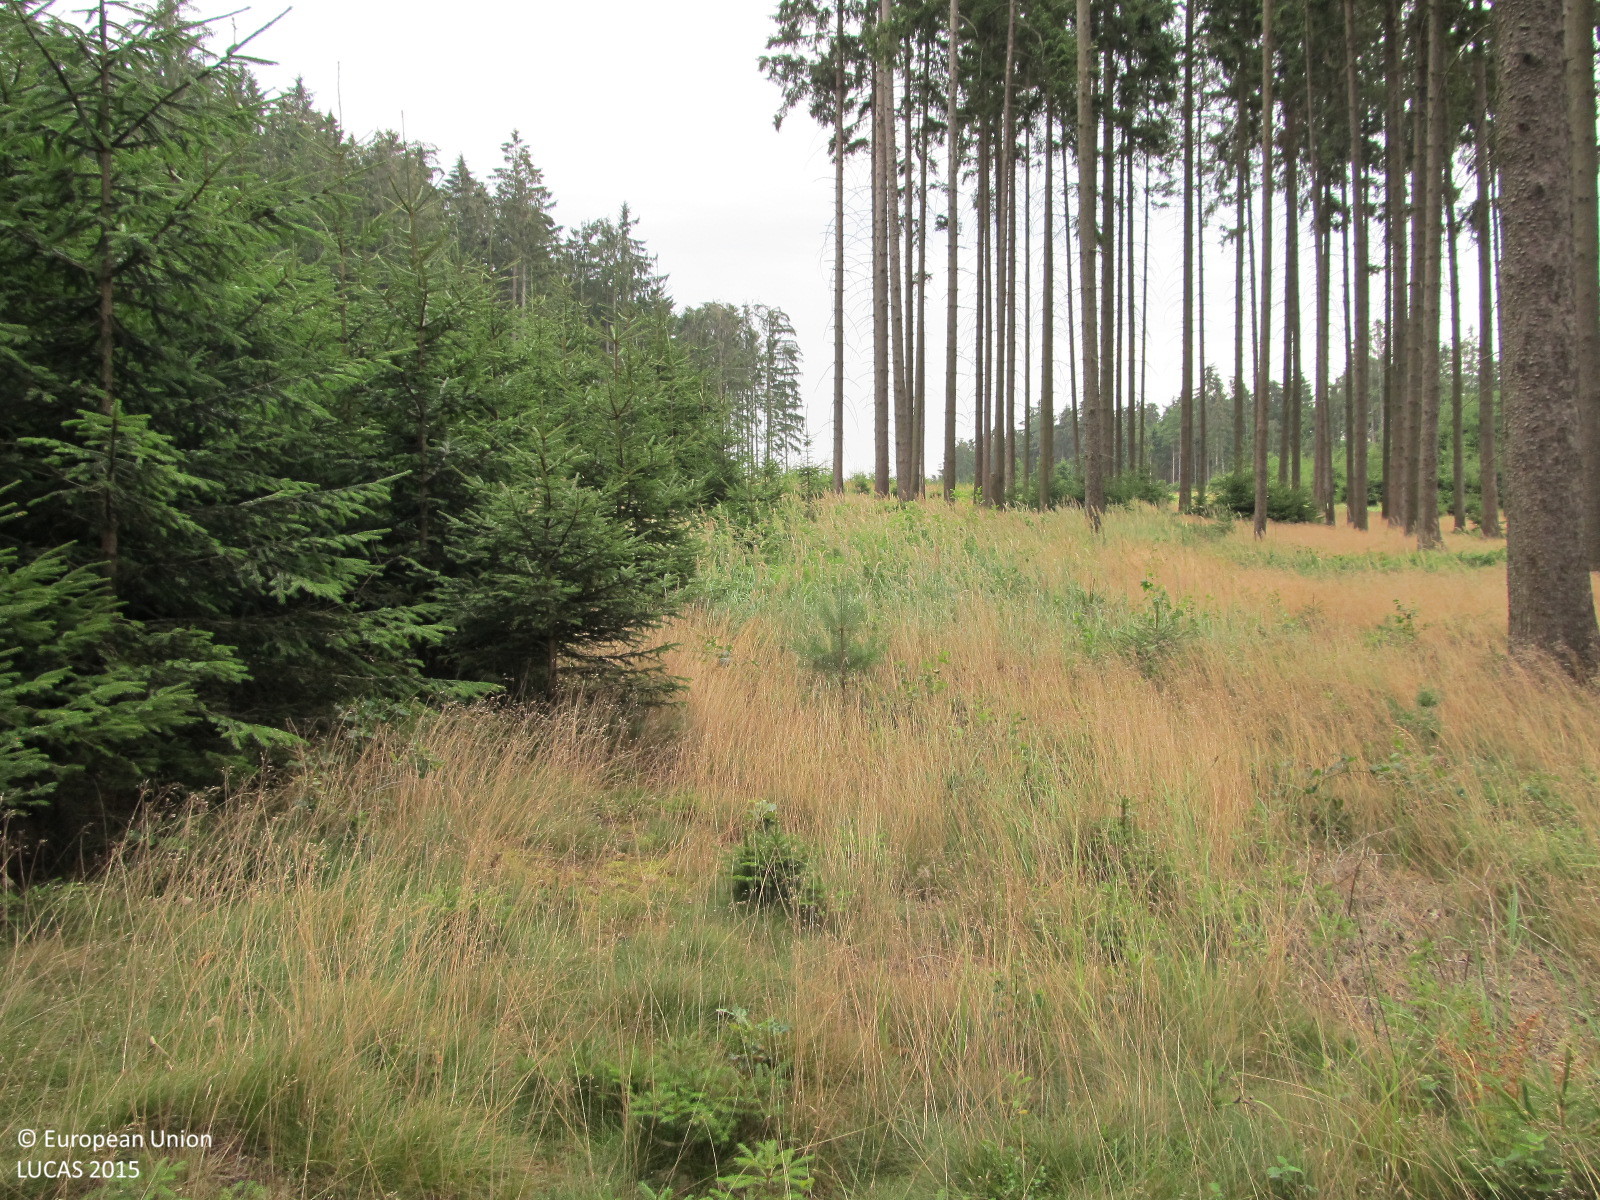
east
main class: Woodland
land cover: Spruce dominated coniferous woodland
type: hemiboreal forest and nemoral coniferous forest and mixed broadleaved-coniferous forest
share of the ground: > 75 %
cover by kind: coniferous forest trees 75 %, herbaceous plants 15 %, shrubs 10 %
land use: Forestry
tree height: > 5 m
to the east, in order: Tracks; Spruce dominated coniferous woodland; Tracks; Spontaneously vegetated surfaces; Spruce dominated coniferous woodland; Paved roads, cycling and walking lanes; Spruce dominated coniferous woodland; Spontaneously vegetated surfaces; Spruce dominated coniferous woodland
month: July
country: AT
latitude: 48.2853
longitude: 15.4875
